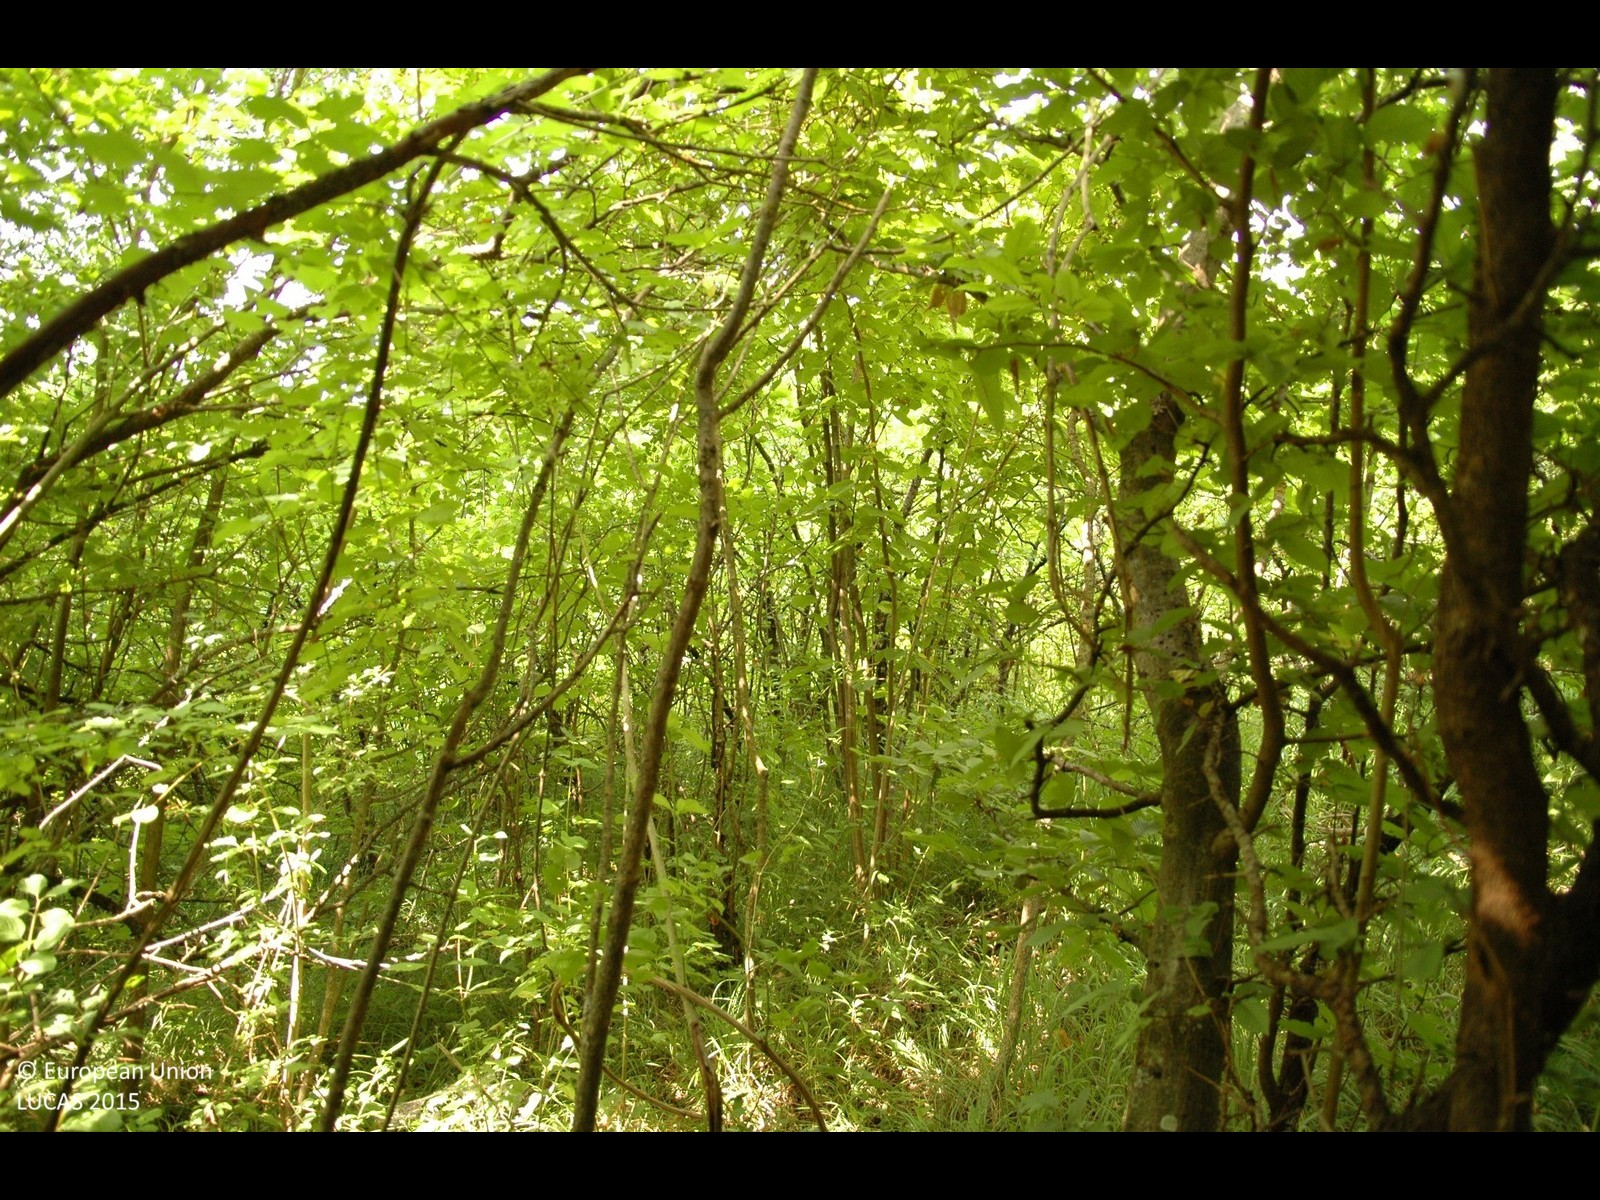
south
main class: Shrubland
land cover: Shrubland without tree cover
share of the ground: > 75 %
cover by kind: shrubs 100 %
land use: Semi-natural and natural areas not in use
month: July
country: HR
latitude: 46.1479
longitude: 16.5904
